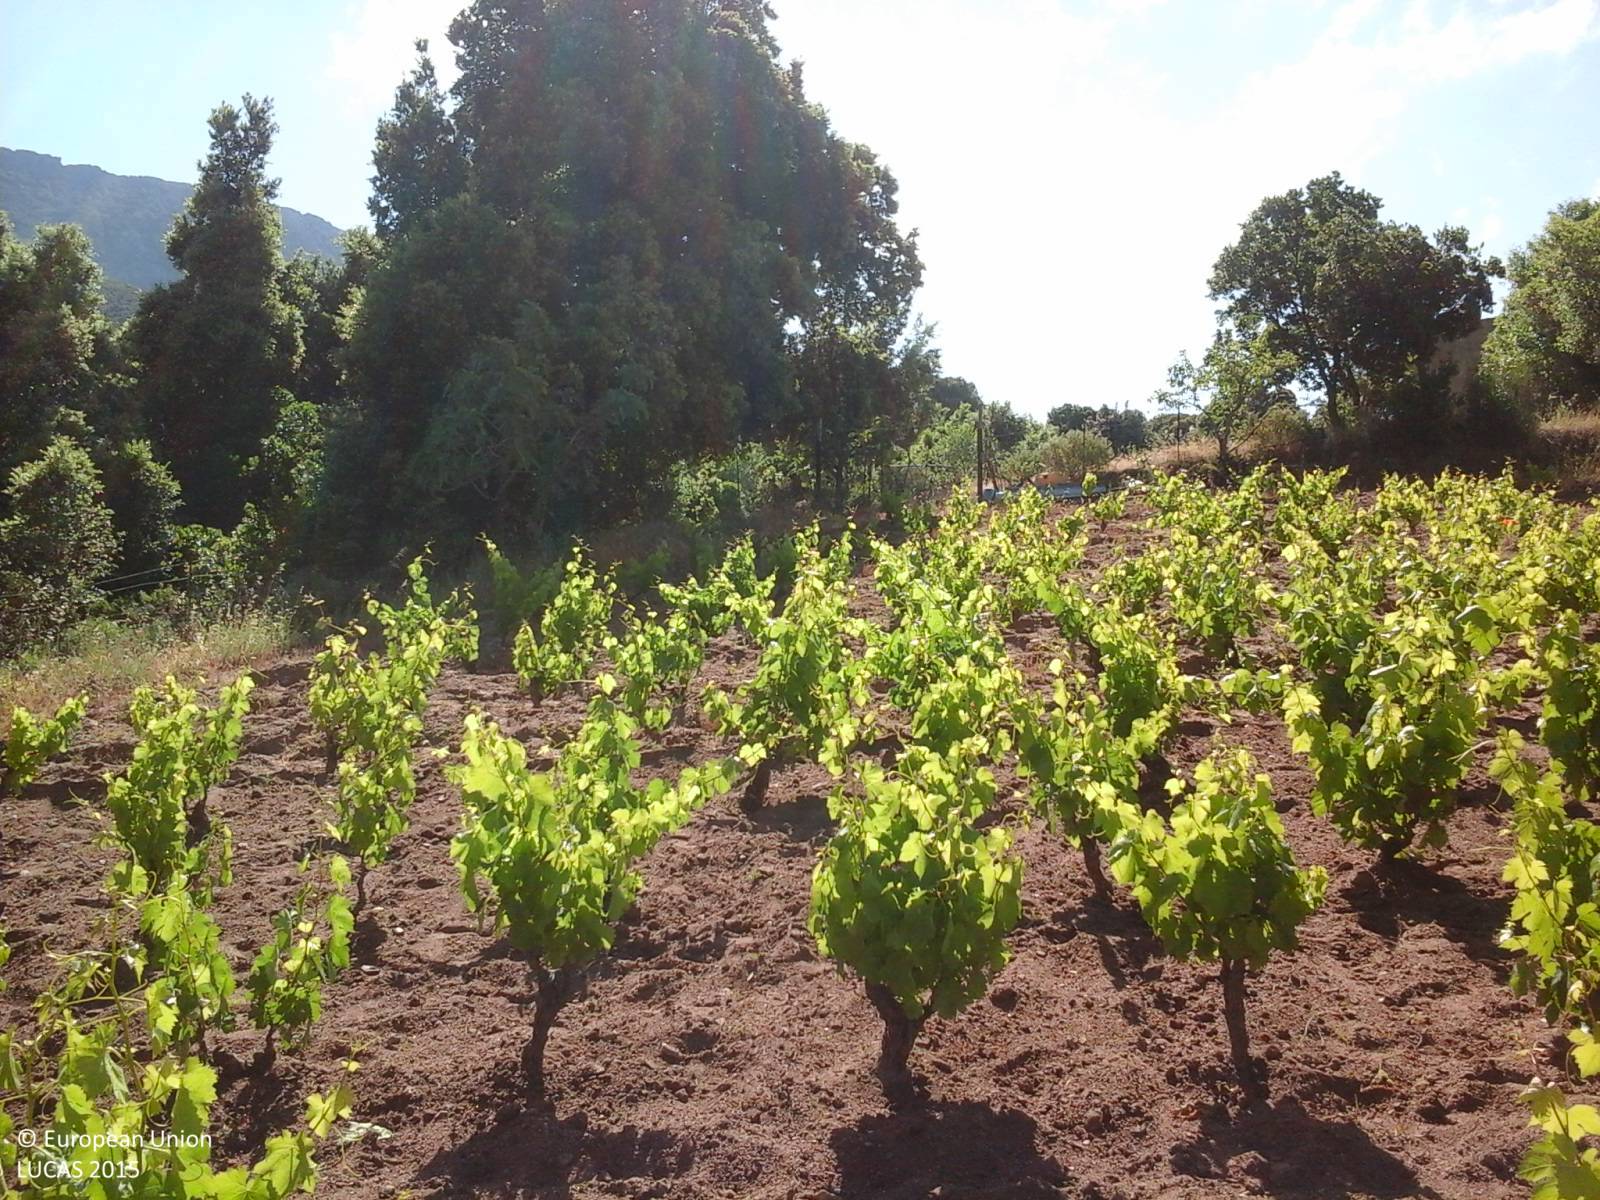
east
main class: Cropland
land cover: Vineyards
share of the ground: 50 - 75 %
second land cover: Other bare soil
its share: > 75 %
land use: Agriculture (excluding fallow land and kitchen gardens)
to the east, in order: Vineyards; Other bare soil; Fences; Abandoned hedges; Spontaneously vegetated surfaces; Dry stone walls; Broadleaved woodland; Tracks; Fences; Grassland with sparse tree/shrub cover; Broadleaved woodland; Rocks and stones; Mixed cereals for fodder
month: May
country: IT
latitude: 40.2293
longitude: 9.4038
